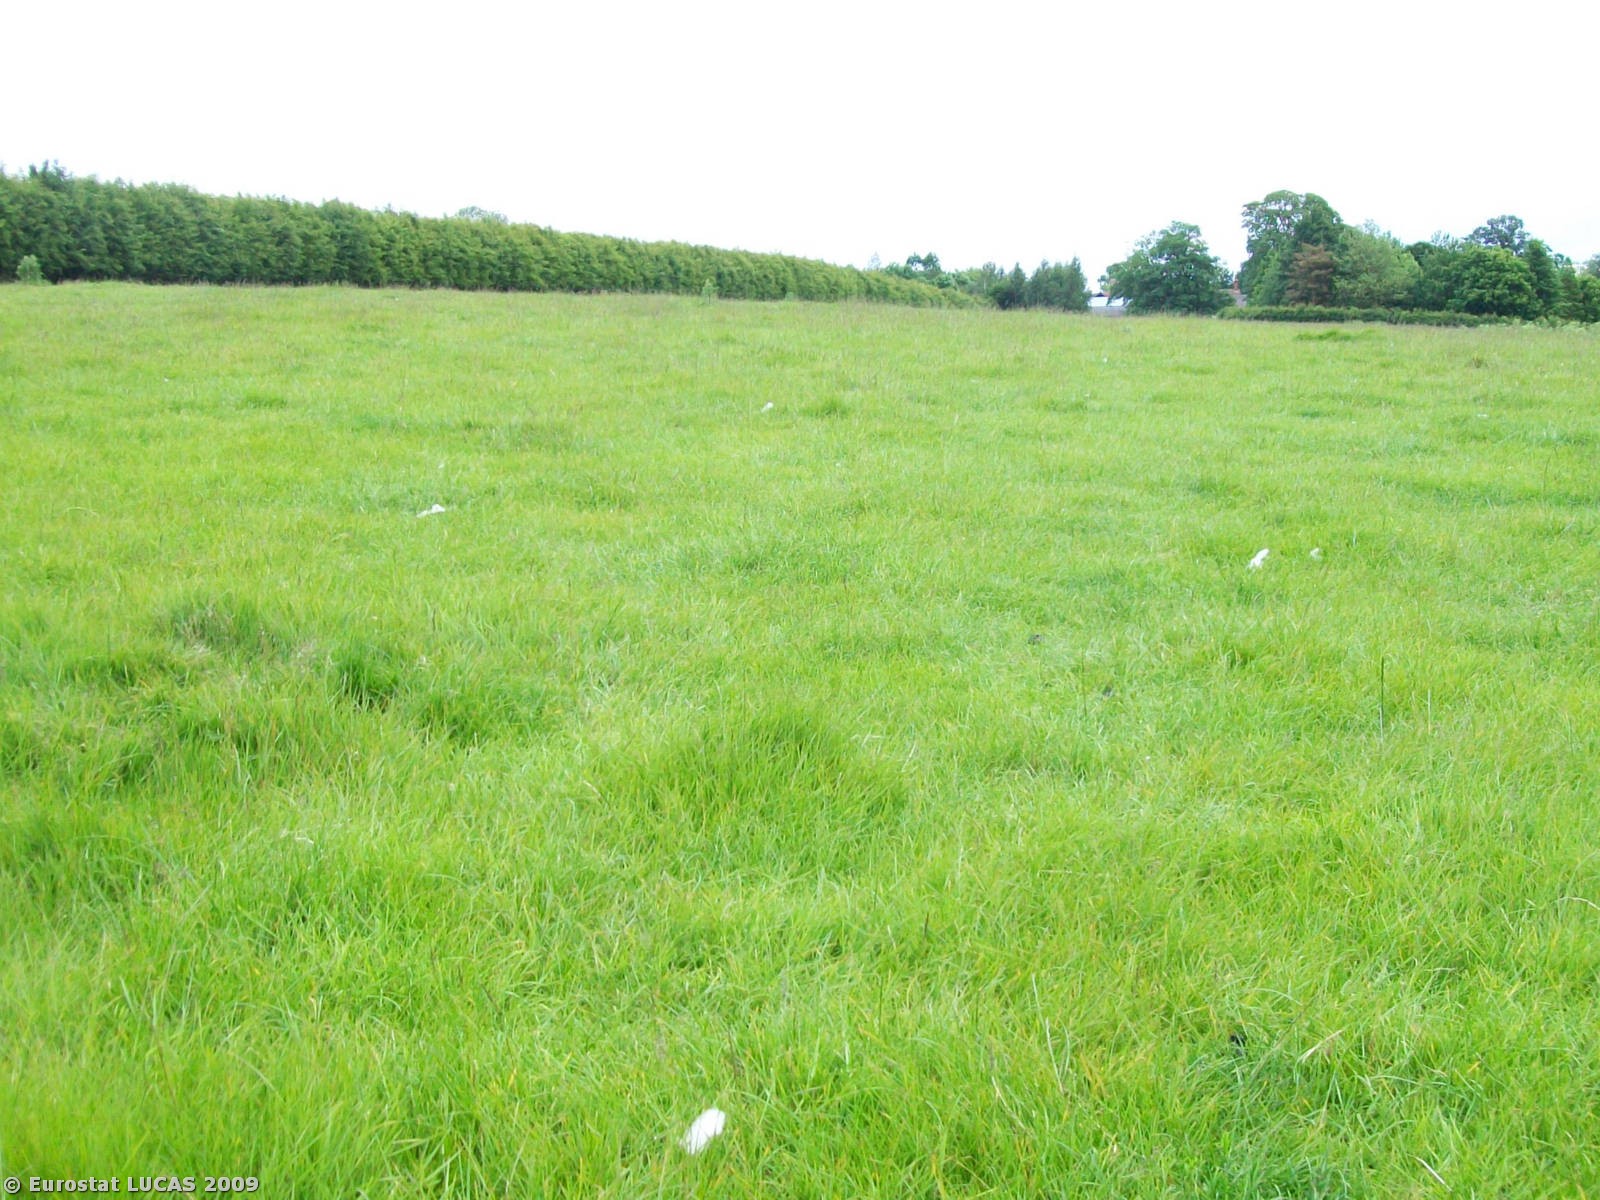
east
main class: Grassland
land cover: Grassland without tree/shrub cover
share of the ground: > 75 %
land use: Agriculture (excluding fallow land and kitchen gardens)
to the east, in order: Grassland without tree/shrub cover; Fences; Grassland without tree/shrub cover; Broadleaved woodland; Grassland without tree/shrub cover; Fences; Grassland without tree/shrub cover
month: June
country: GB
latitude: 52.6083
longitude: -0.8070
